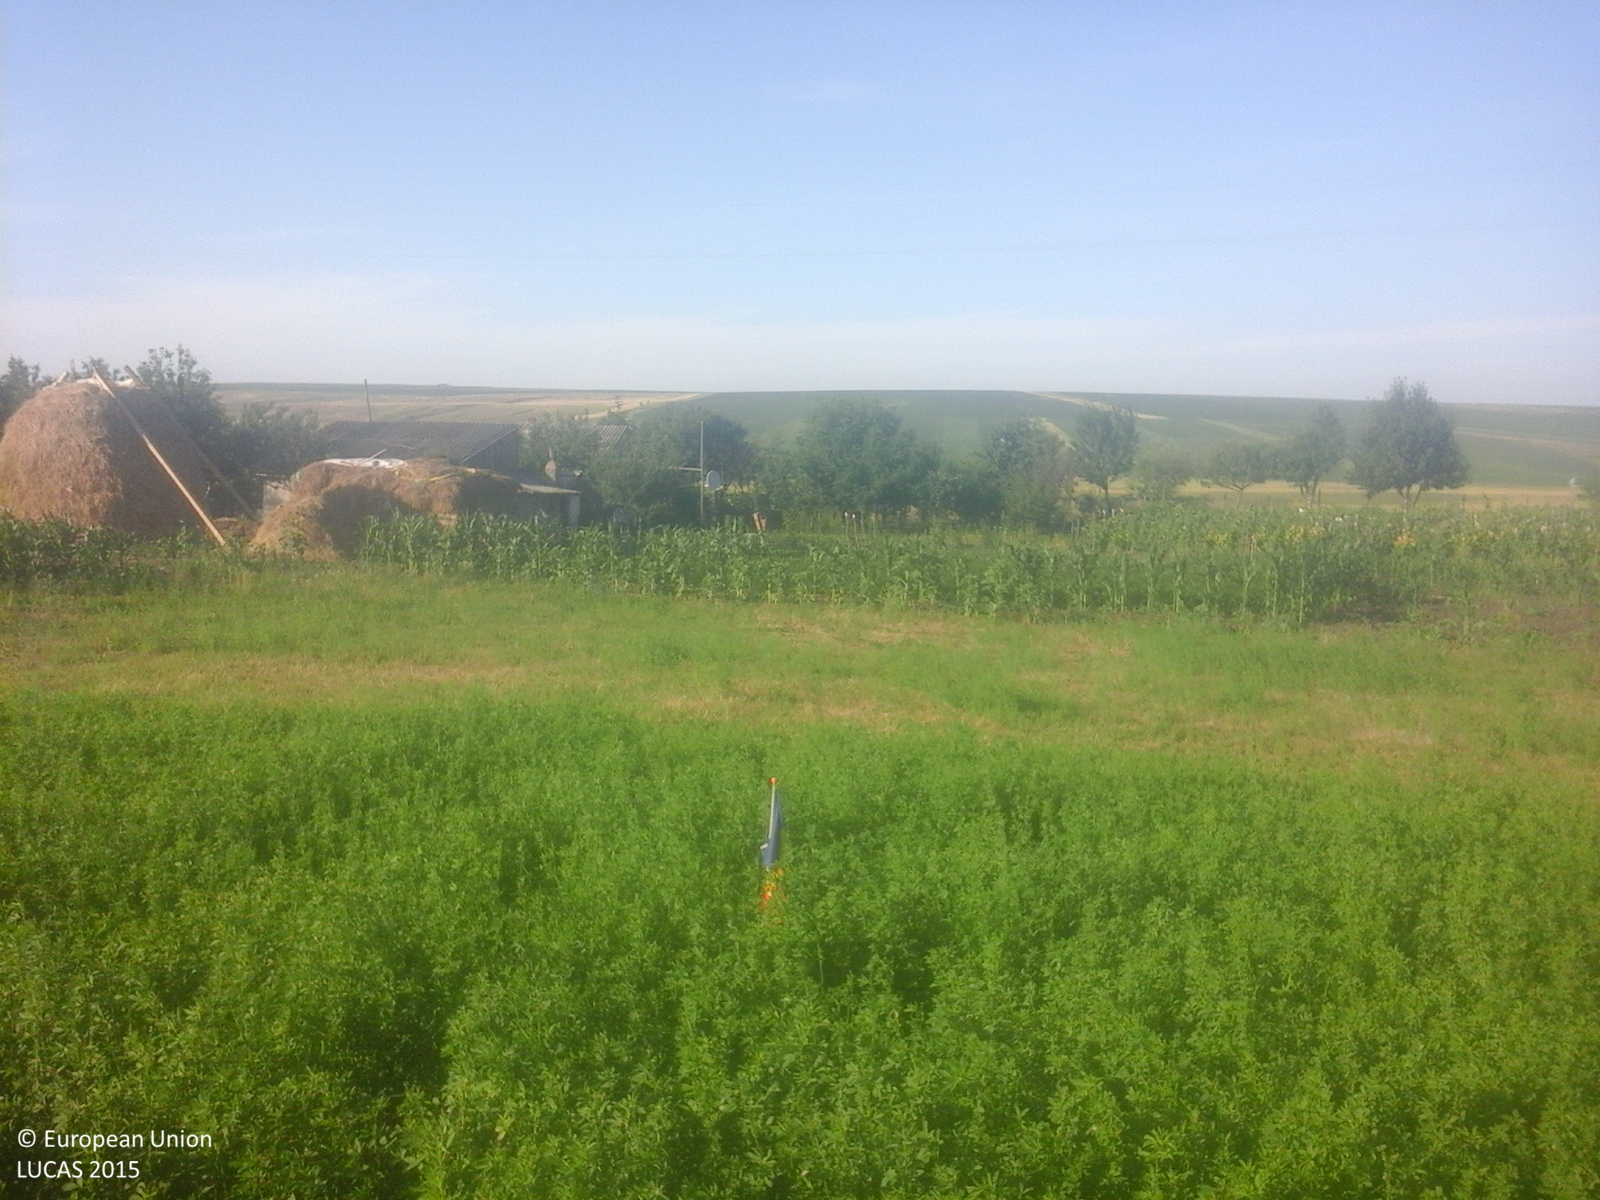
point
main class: Cropland
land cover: Lucerne
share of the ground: > 75 %
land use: Agriculture (excluding fallow land and kitchen gardens)
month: June
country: RO
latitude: 47.8796
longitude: 27.0214
